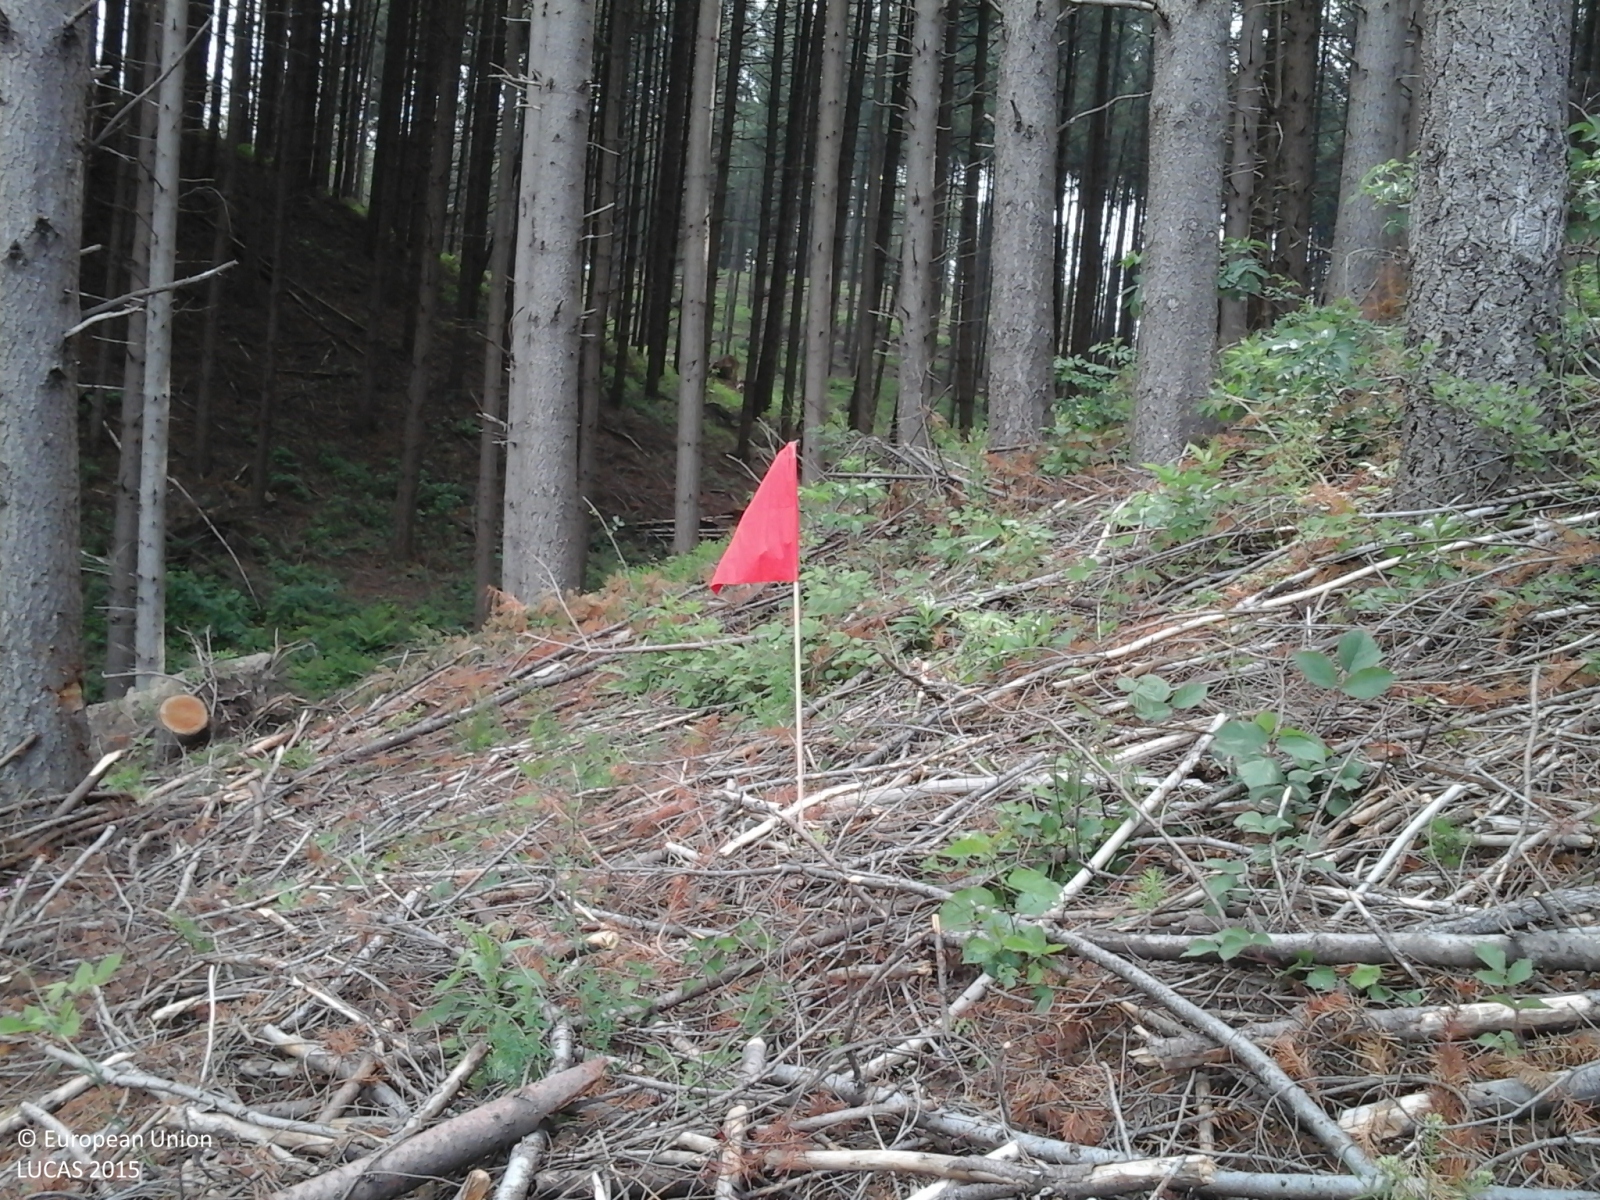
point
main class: Woodland
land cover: Spruce dominated coniferous woodland
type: coniferous forest of the mediterranean region
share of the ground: > 75 %
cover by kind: coniferous forest trees 100 %
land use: Forestry
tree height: > 5 m
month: May
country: IT
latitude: 44.0732
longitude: 11.1833
